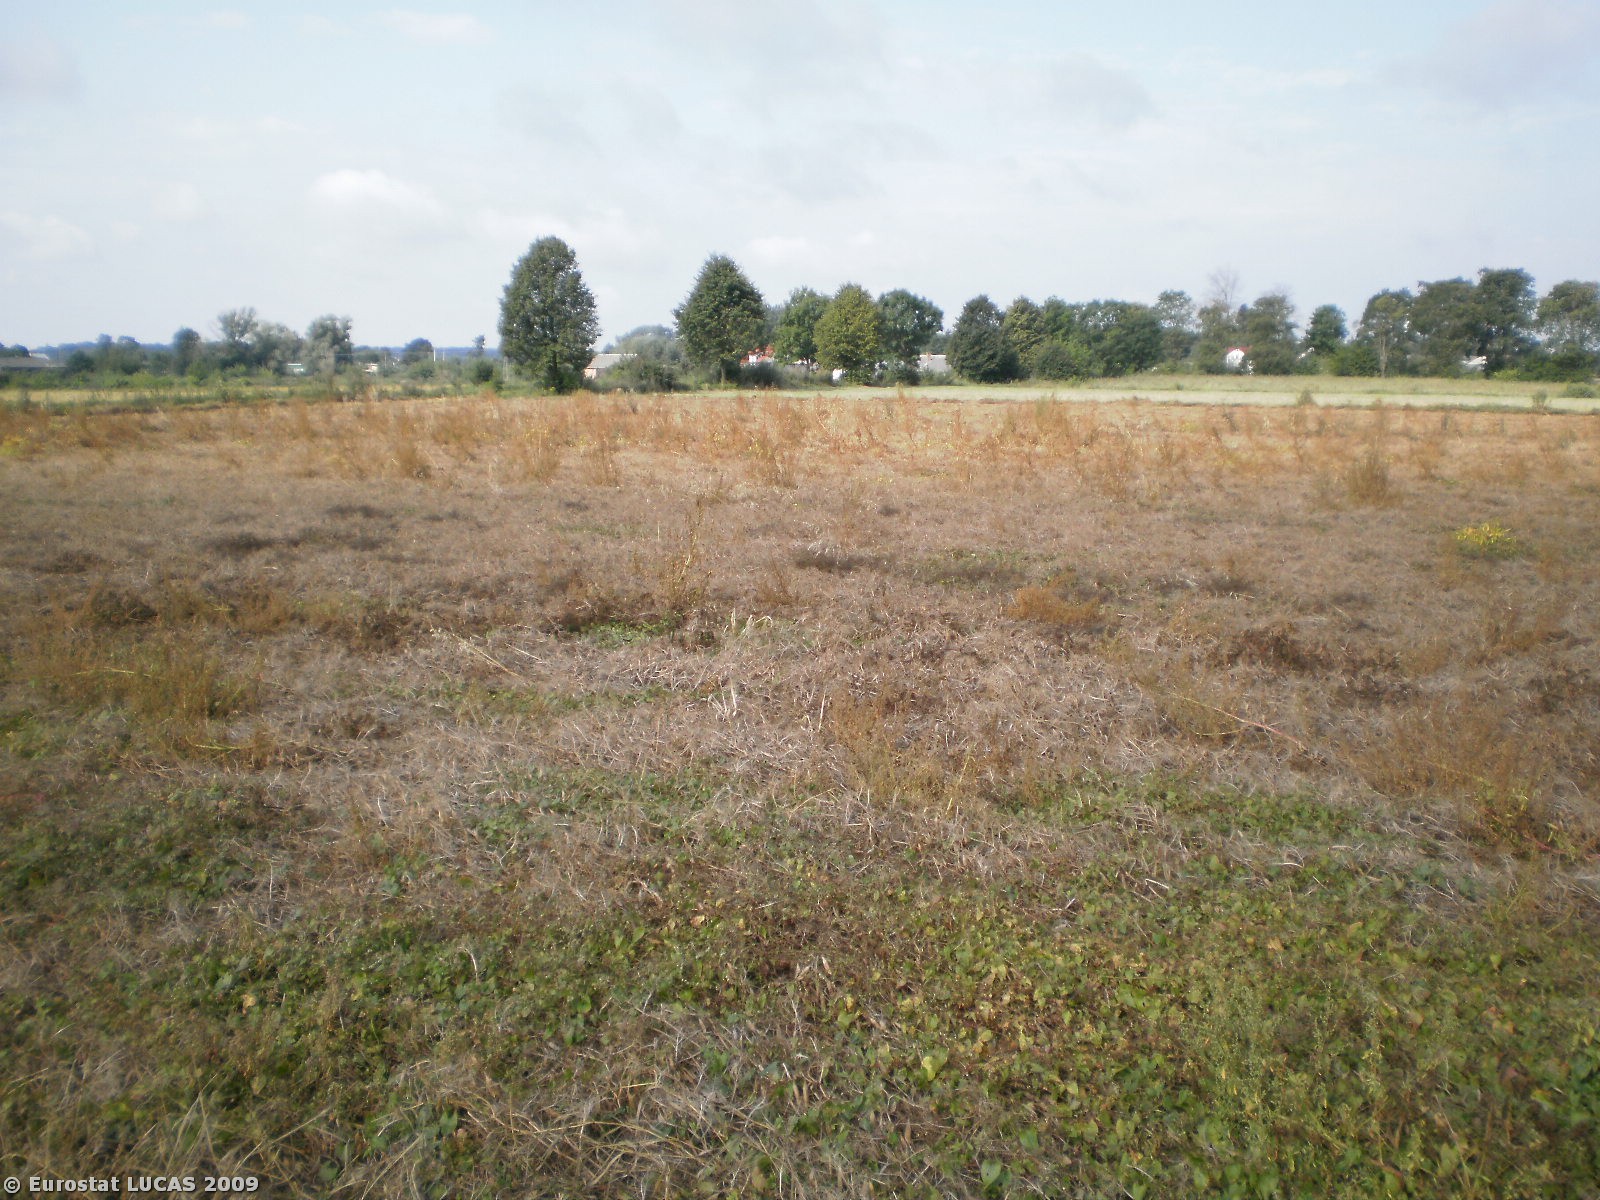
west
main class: Cropland
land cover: Dry pulses
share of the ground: > 75 %
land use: Agriculture (excluding fallow land and kitchen gardens)
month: August
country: PL
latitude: 52.9346
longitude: 21.0092
